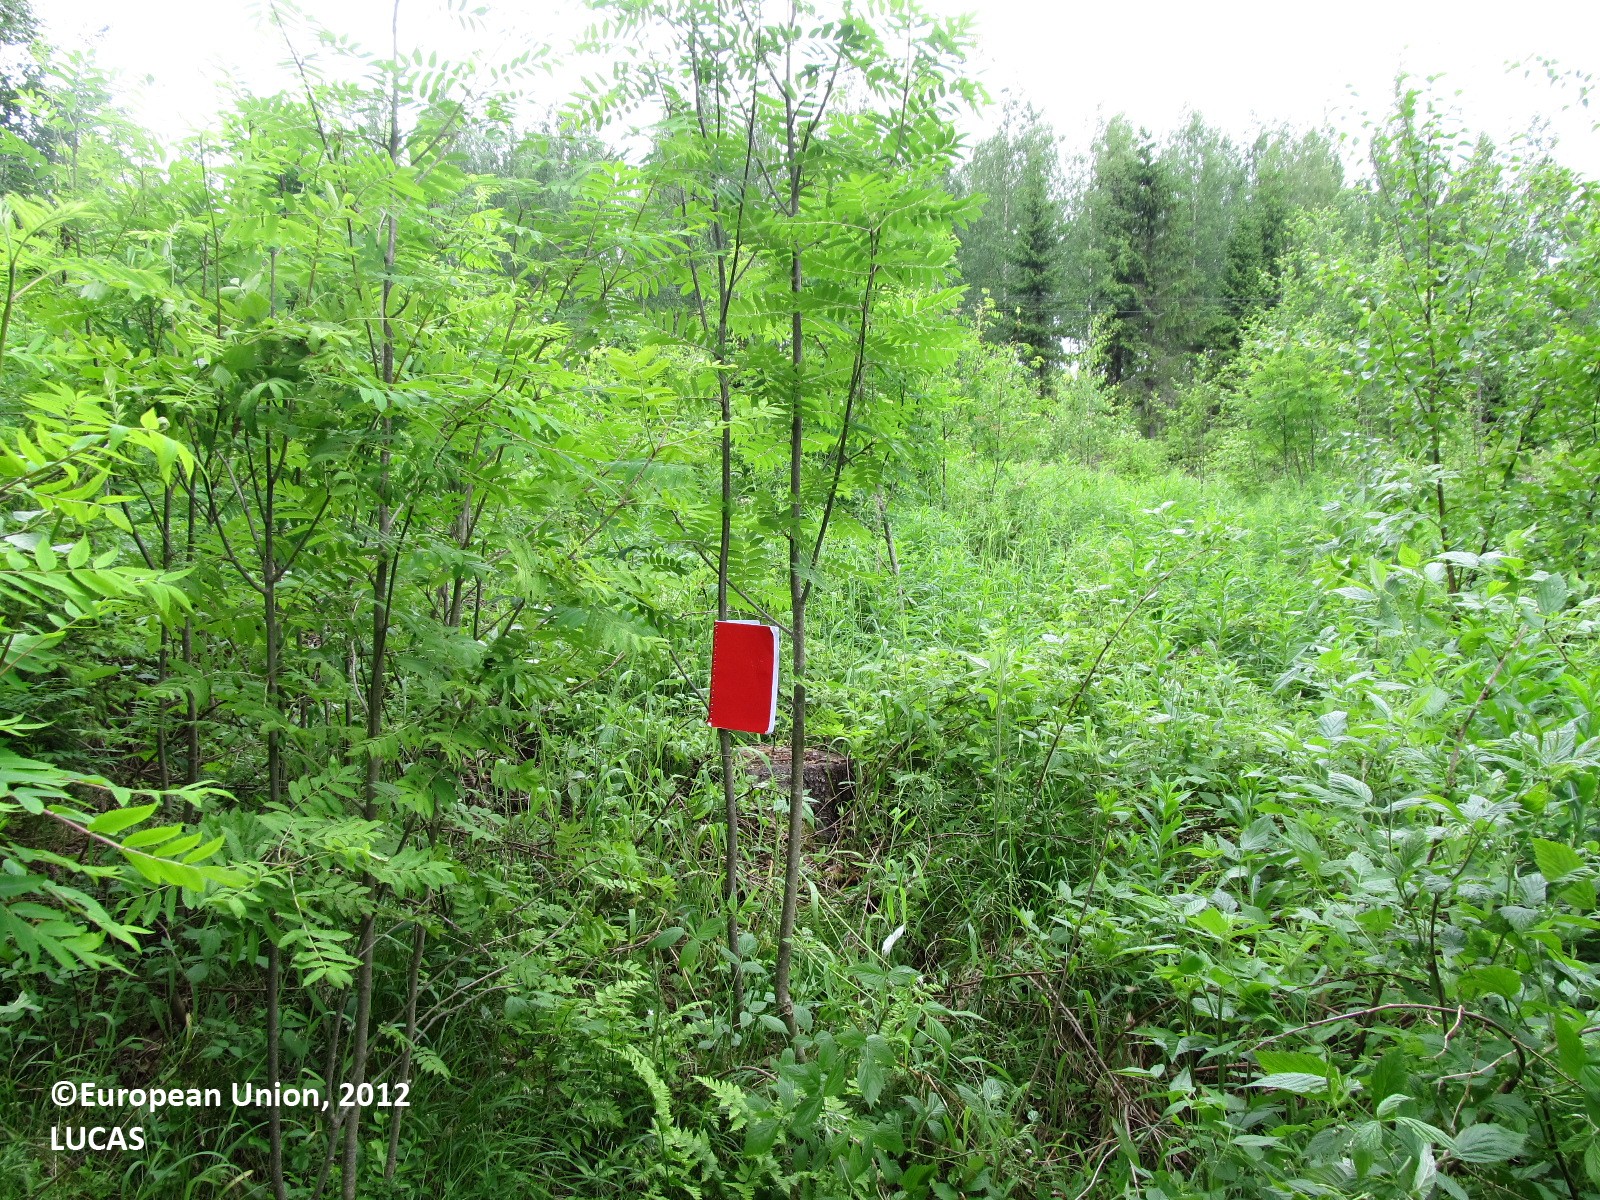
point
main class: Woodland
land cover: Broadleaved woodland
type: boreal forest
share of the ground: 50 - 75 %
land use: Forestry
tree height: < 5 m
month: June
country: FI
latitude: 63.1886
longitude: 27.6721
